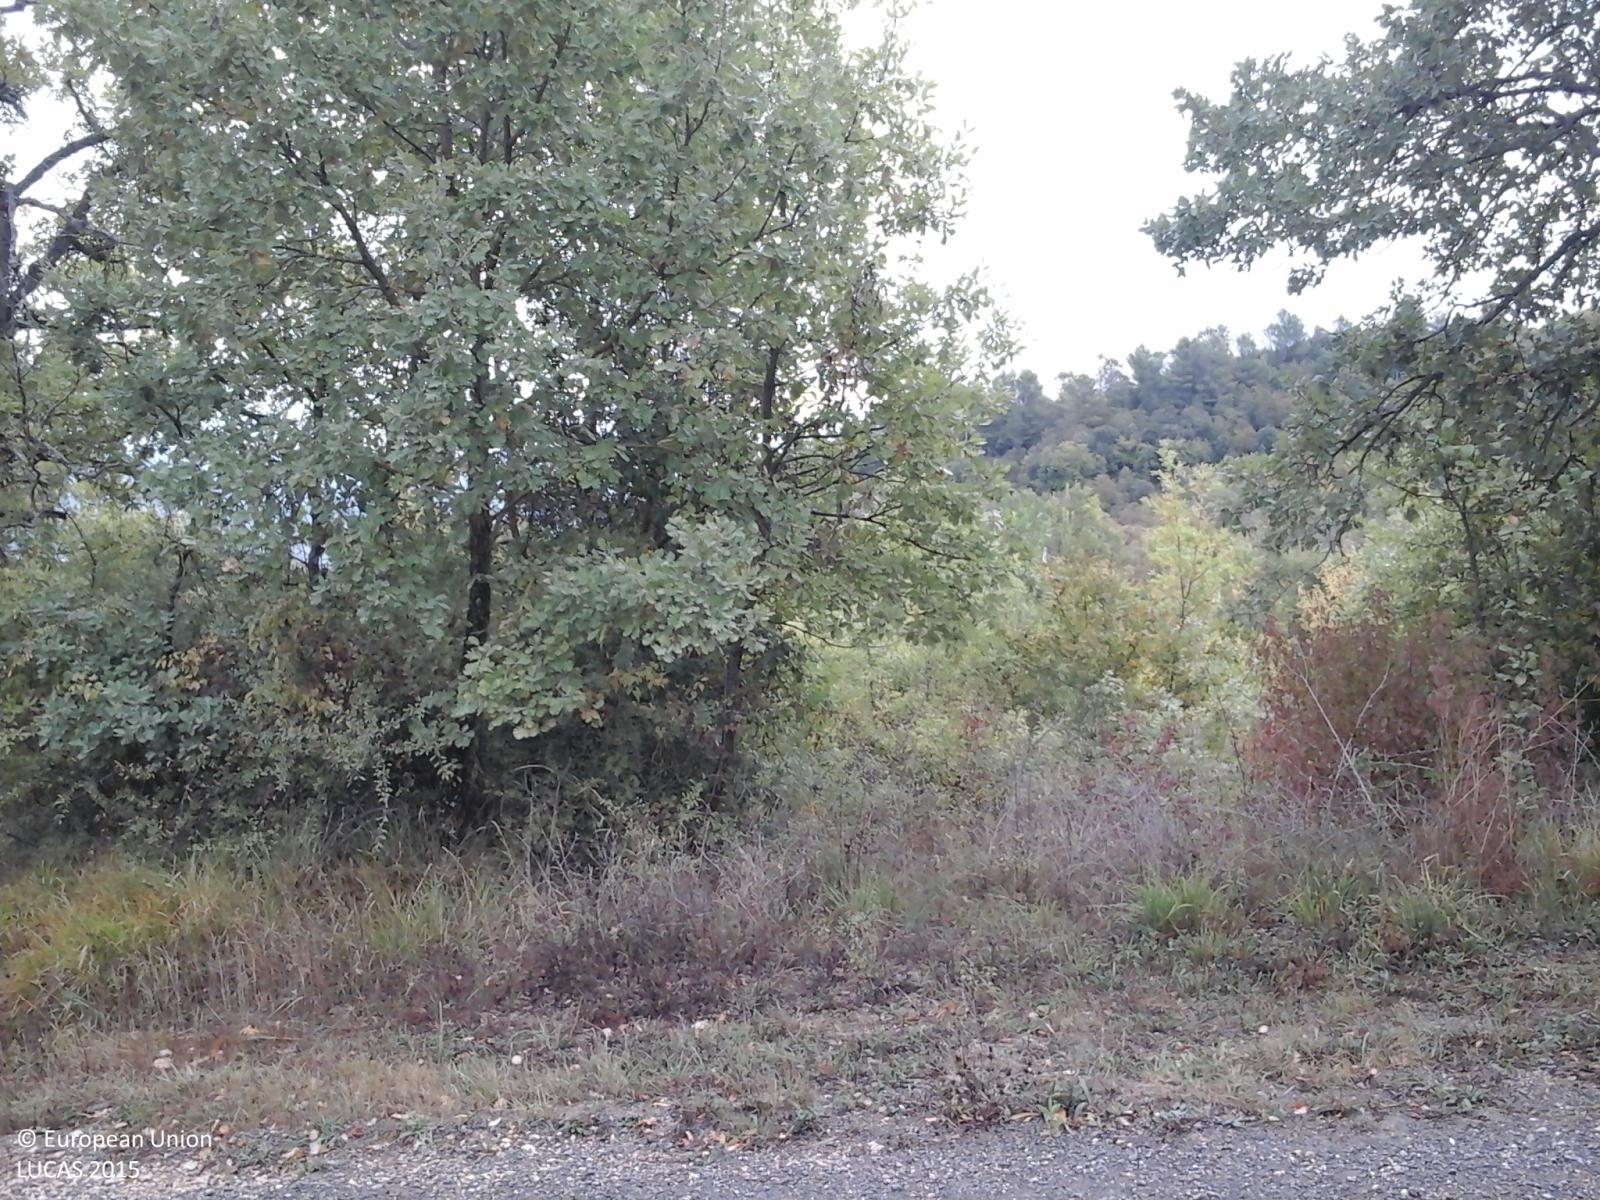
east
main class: Woodland
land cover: Broadleaved woodland
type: thermophilous deciduous forest
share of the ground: > 75 %
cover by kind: broadleaved forest trees 90 %, shrubs 10 %
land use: Forestry
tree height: > 5 m
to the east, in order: Broadleaved woodland; Ditches and canals; Paved roads, cycling and walking lanes; Grass margins; Broadleaved woodland
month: October
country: IT
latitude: 43.1677
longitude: 12.3917
